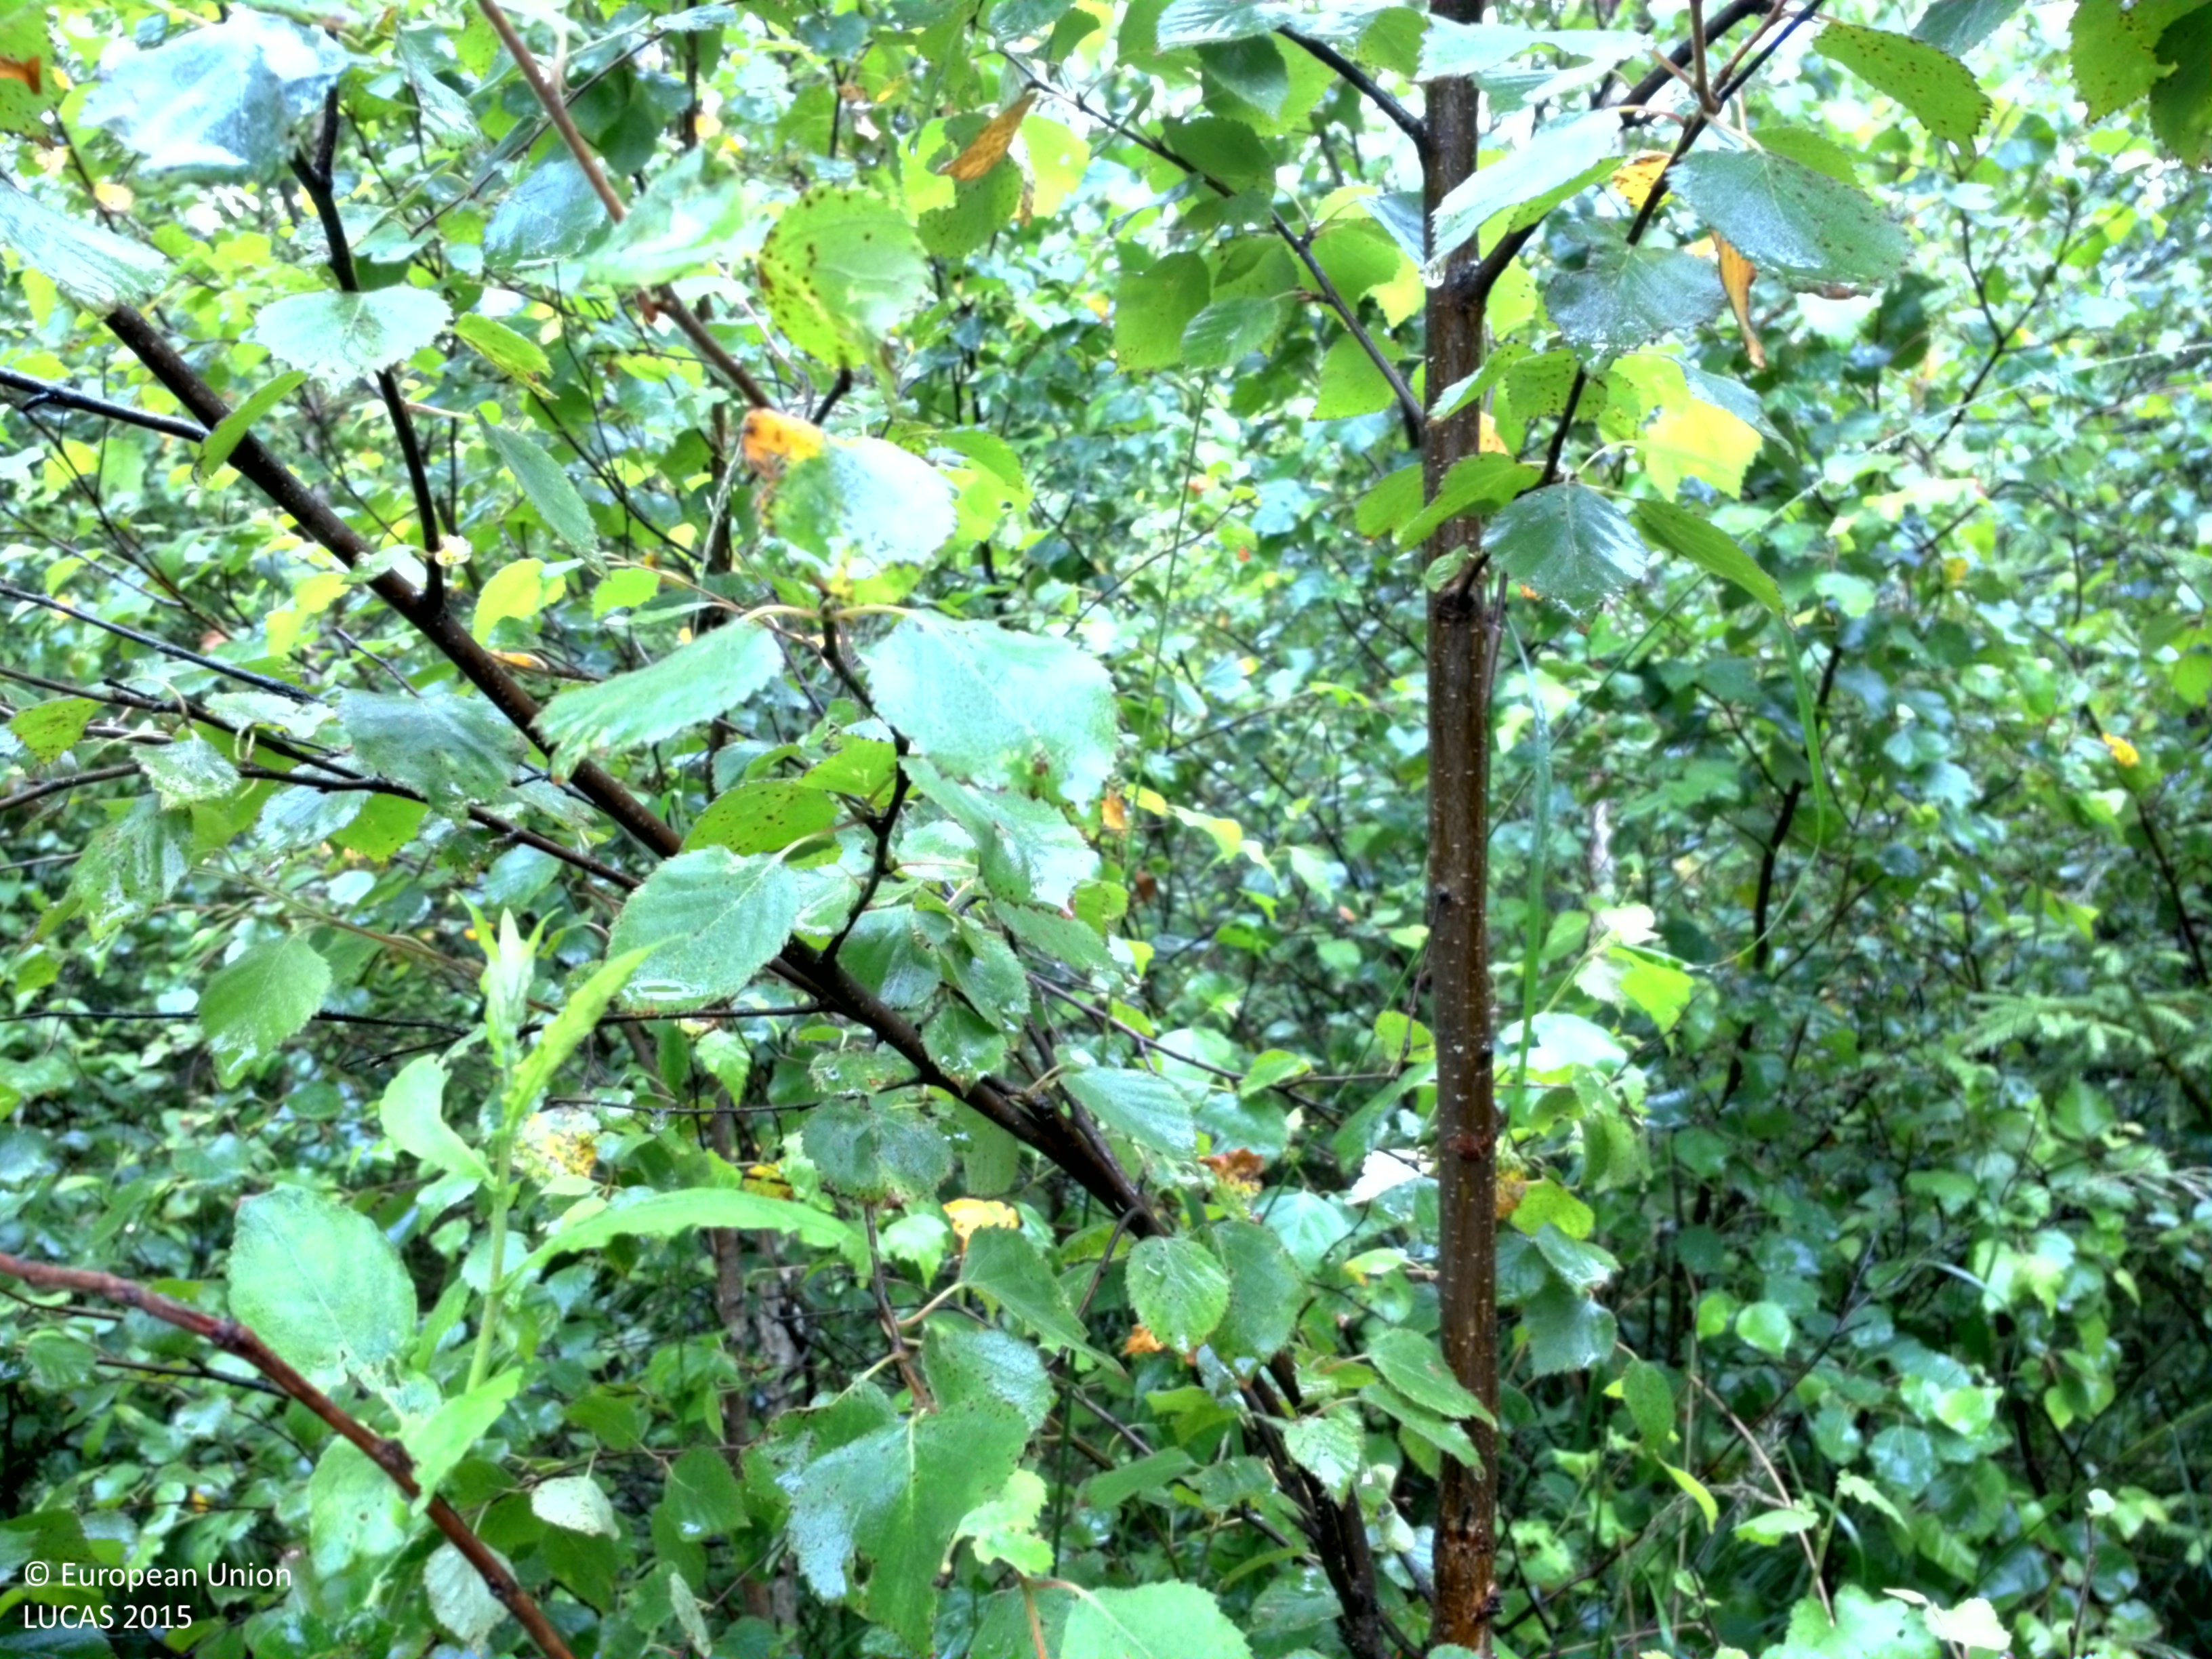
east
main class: Woodland
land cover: Spruce dominated mixed woodland
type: boreal forest
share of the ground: > 75 %
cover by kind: coniferous forest trees 50 %, broadleaved forest trees 40 %, herbaceous plants 5 %, lichens and mosses 5 %
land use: Forestry
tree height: > 5 m
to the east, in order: Spruce dominated mixed woodland; Inland marshes; Spruce dominated mixed woodland; Spruce dominated coniferous woodland
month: July
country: SE
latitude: 59.8592
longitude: 18.3713
